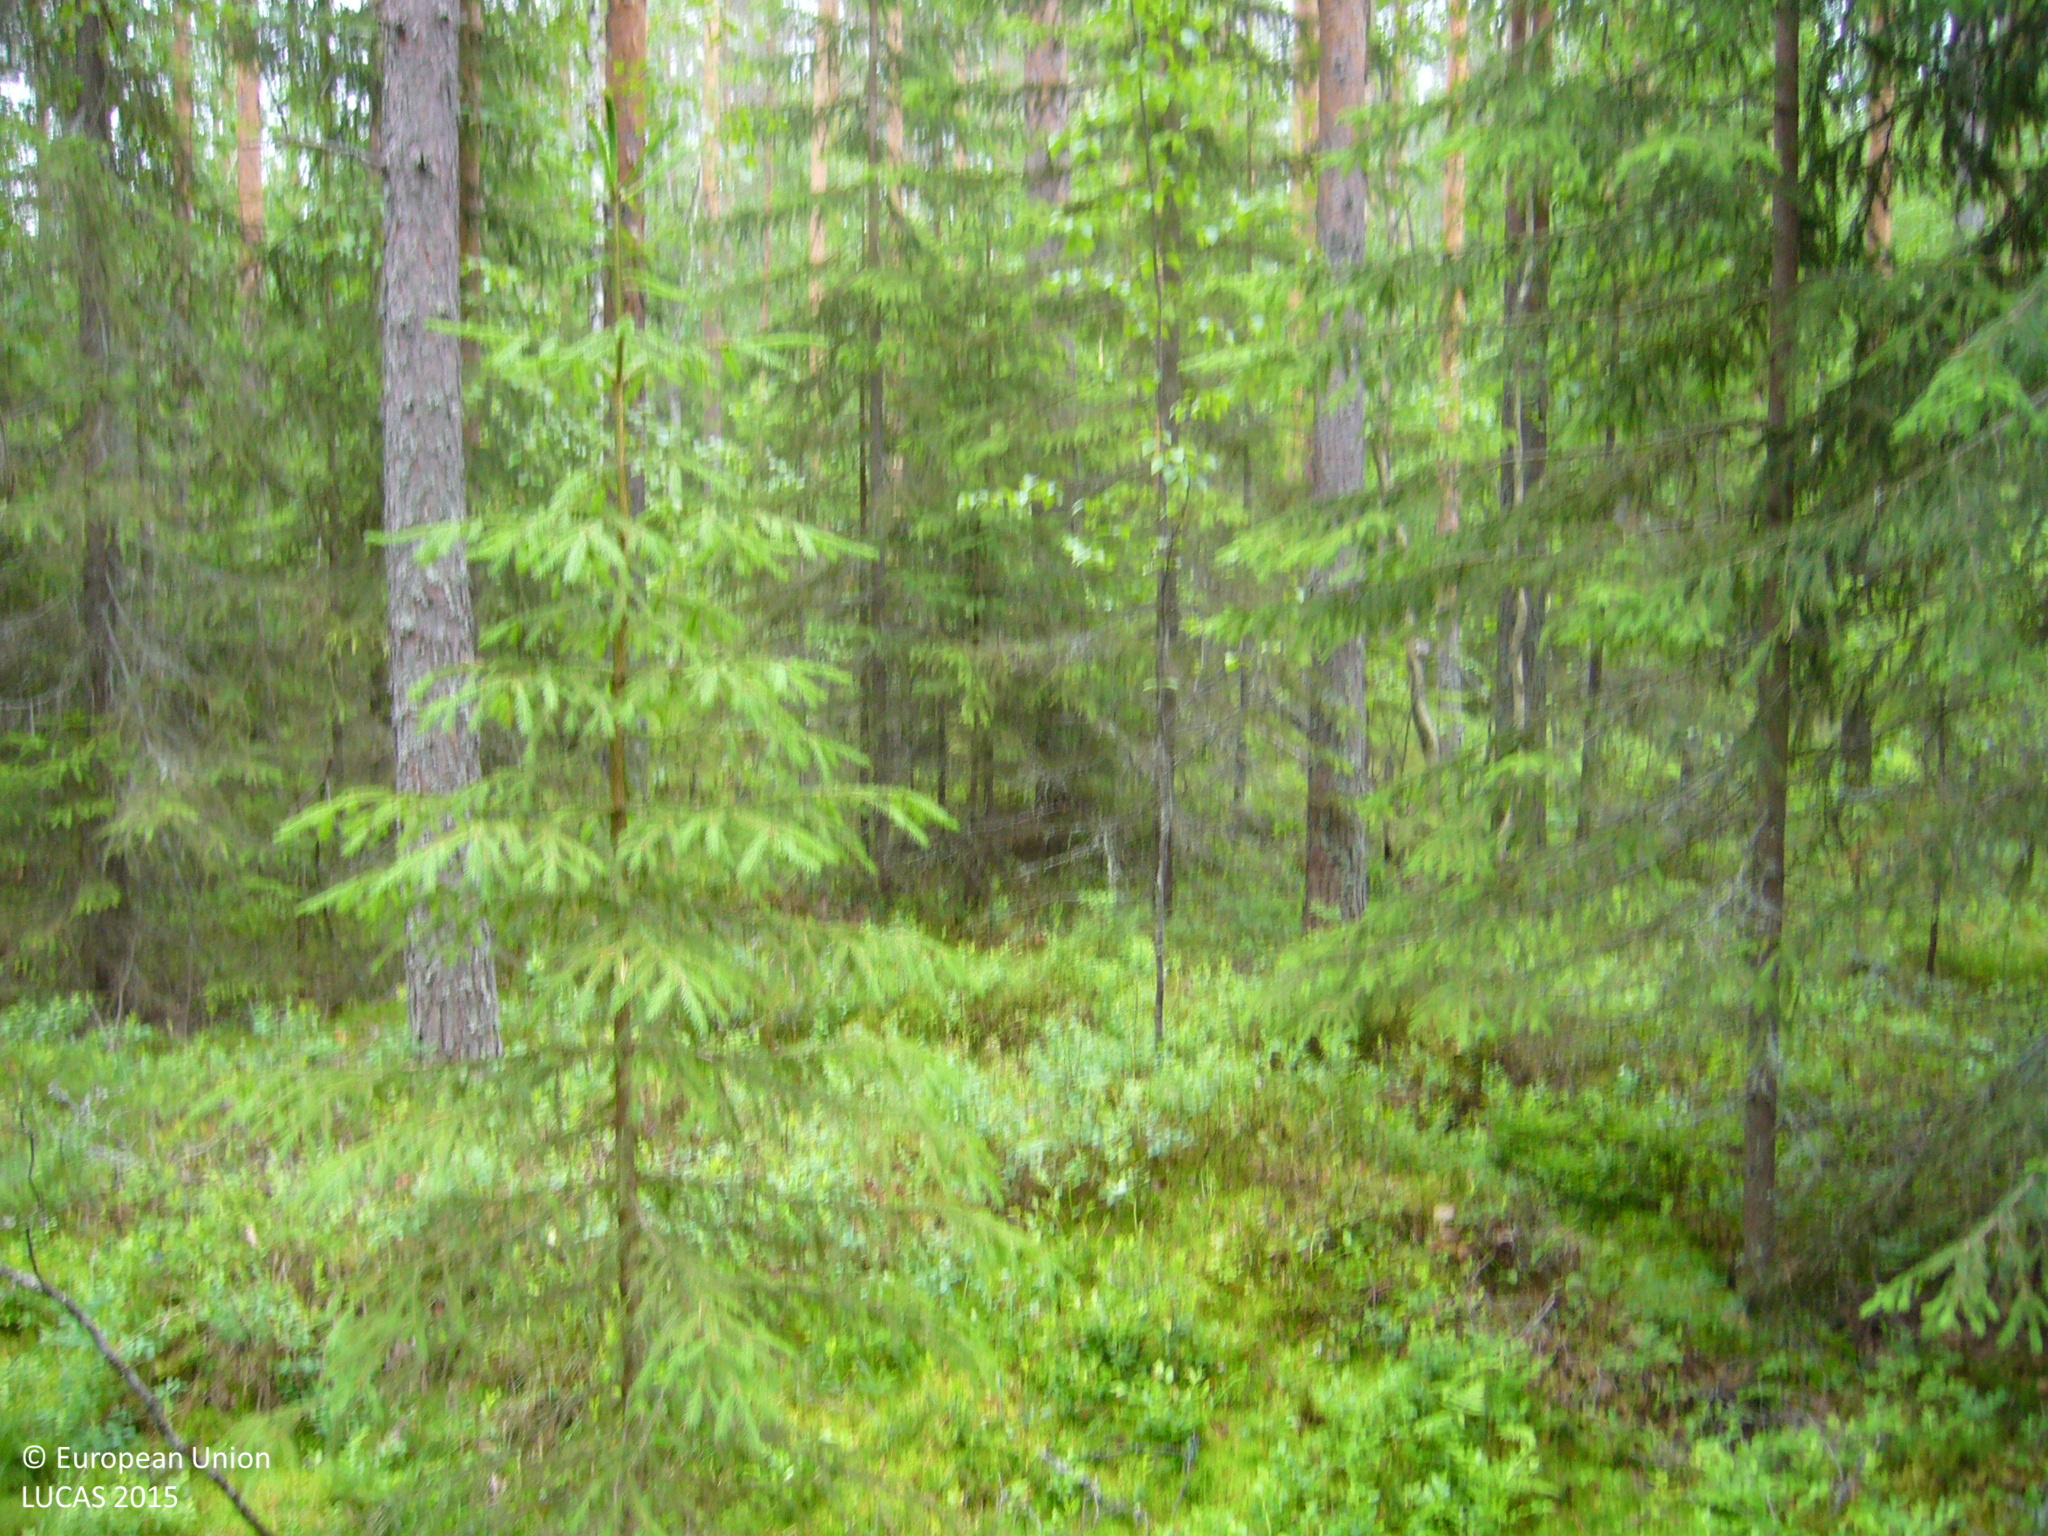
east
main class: Woodland
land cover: Pine dominated mixed woodland
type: boreal forest
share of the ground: > 75 %
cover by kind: coniferous forest trees 50 %, broadleaved forest trees 25 %, shrubs 25 %
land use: Forestry
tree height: > 5 m
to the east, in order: Pine dominated mixed woodland; Ditches and canals; Pine dominated mixed woodland; Spruce dominated mixed woodland; Ditches and canals; Spruce dominated mixed woodland; Ditches and canals; Spruce dominated mixed woodland; Pine dominated mixed woodland; Spruce dominated mixed woodland; Ditches and canals; Shruby margins; Paved roads, cycling and walking lanes; Shruby margins; Ditches and canals; Pine dominated mixed woodland
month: July
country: FI
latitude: 63.4275
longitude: 26.3741
